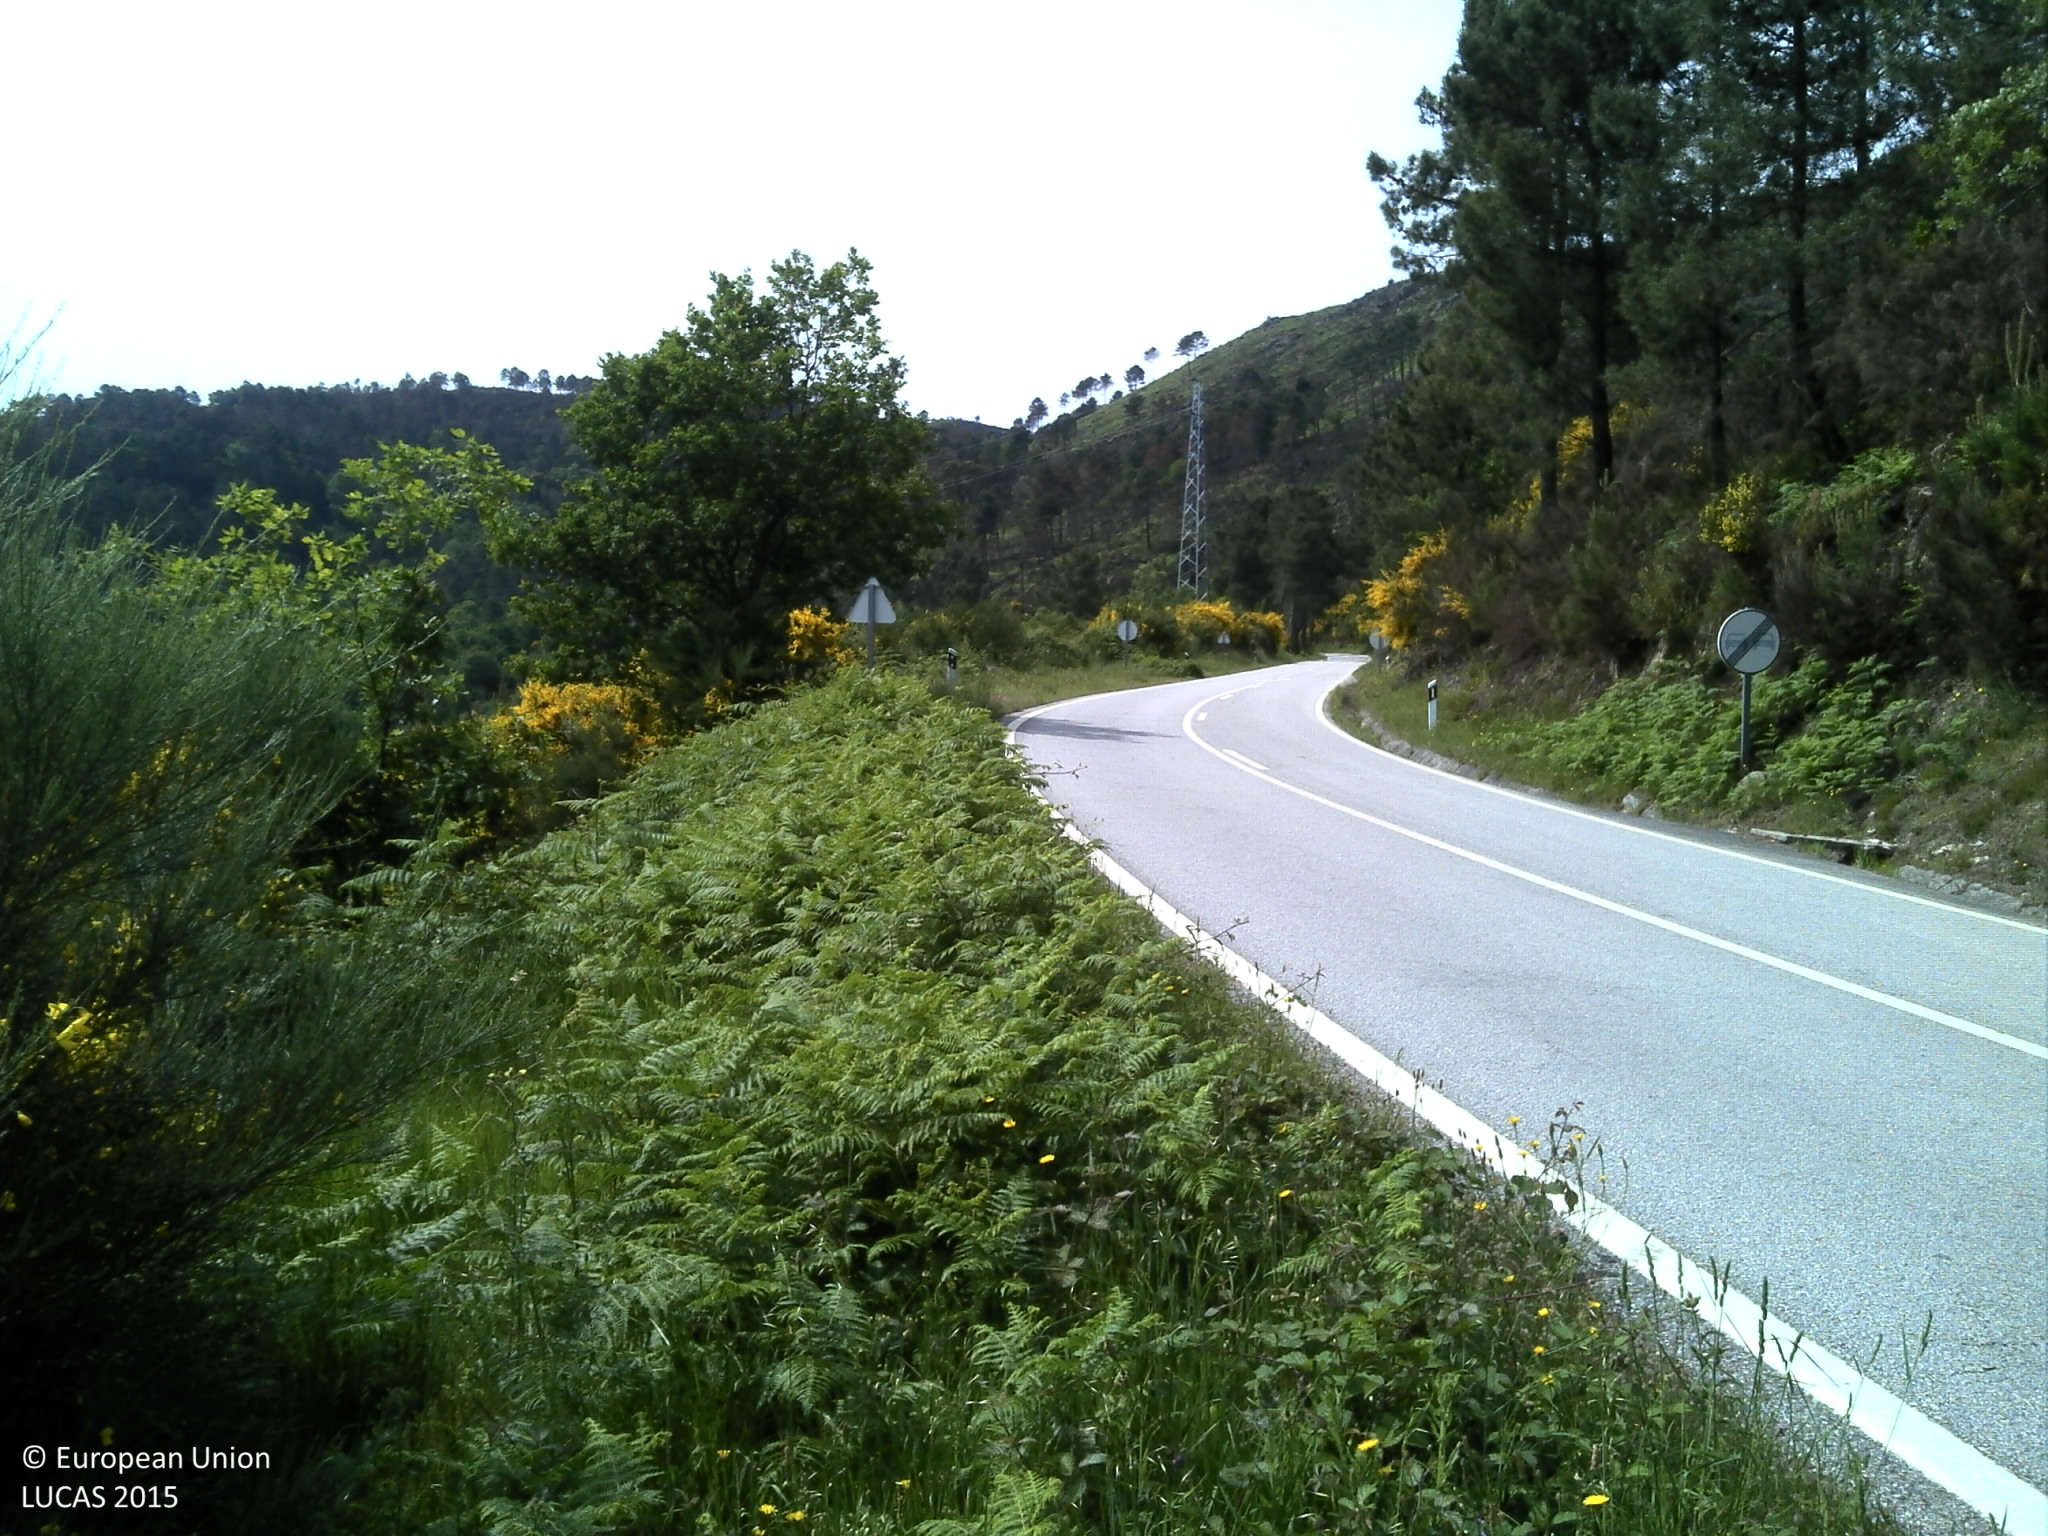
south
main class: Shrubland
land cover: Shrubland without tree cover
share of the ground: 50 - 75 %
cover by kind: shrubs 75 %, herbaceous plants 10 %, consolidated bare surface 10 %, unconsolidated bare surface 5 %
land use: Abandoned areas
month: May
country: PT
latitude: 41.0331
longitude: -8.0597
